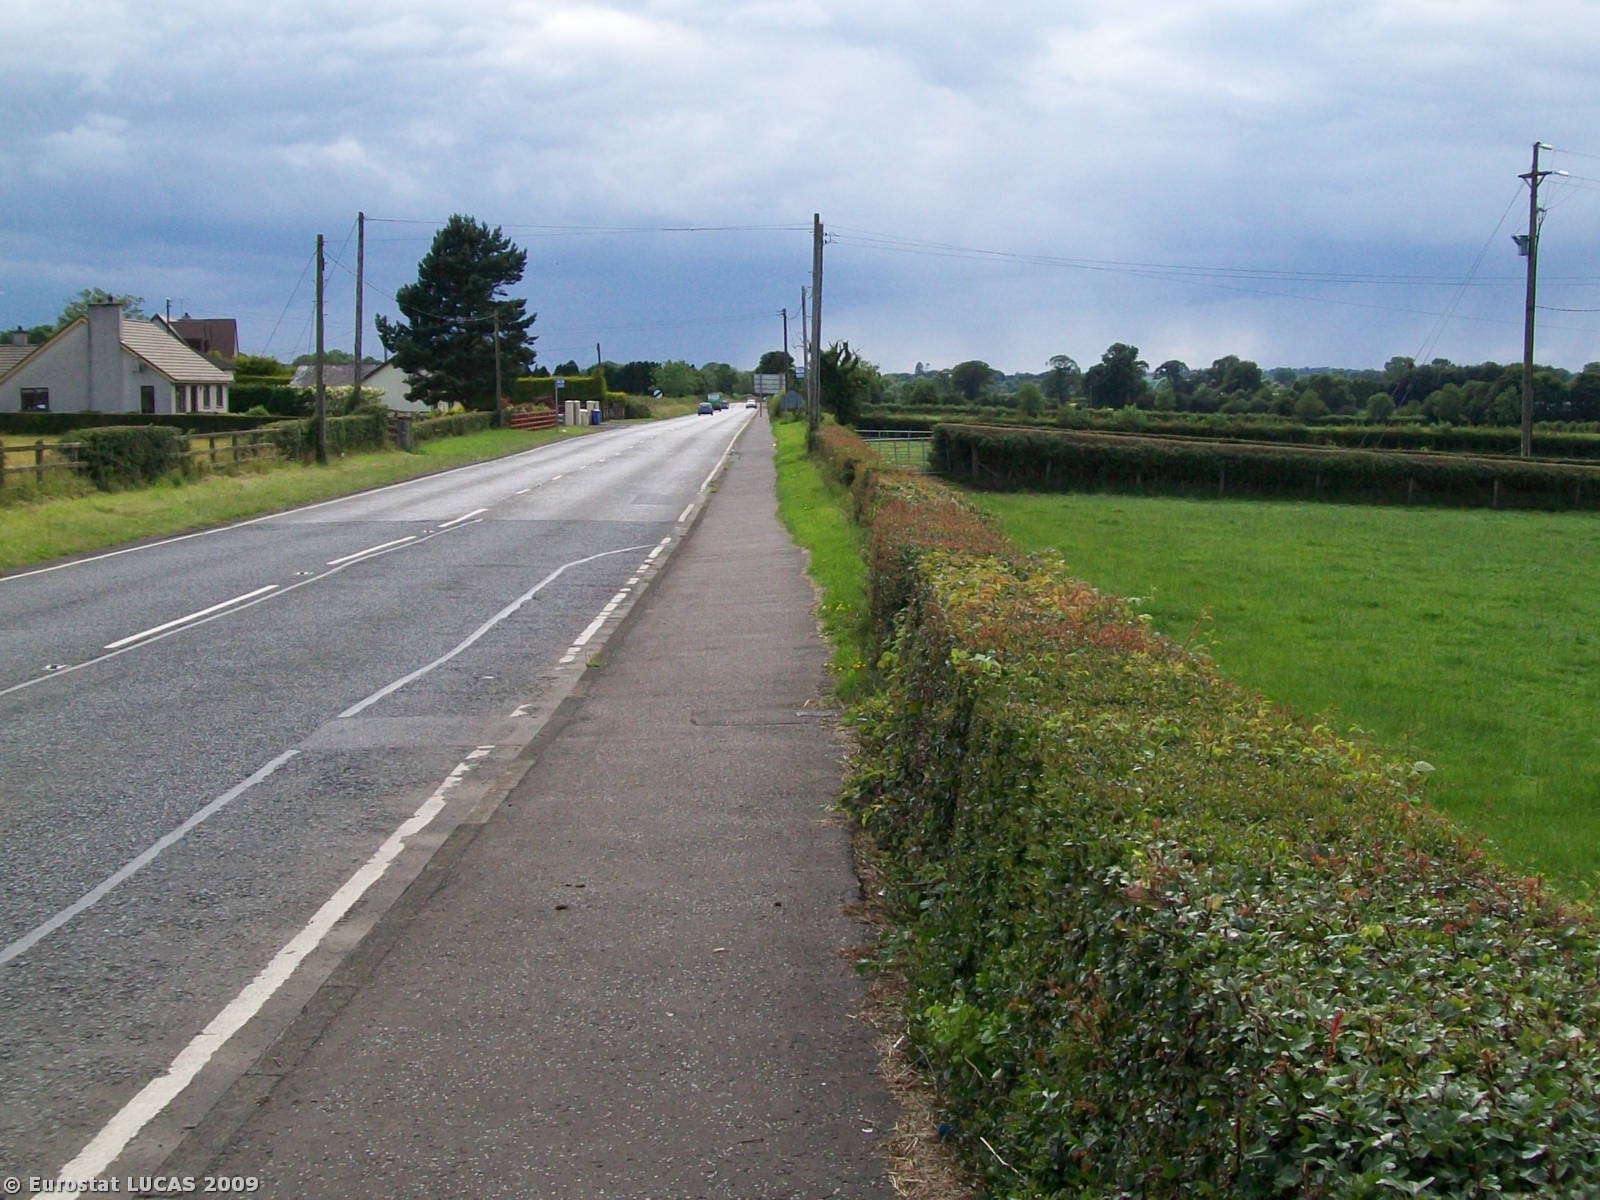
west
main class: Grassland
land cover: Grassland without tree/shrub cover
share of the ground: > 75 %
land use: Agriculture (excluding fallow land and kitchen gardens)
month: July
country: GB
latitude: 54.7002
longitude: -6.1108
